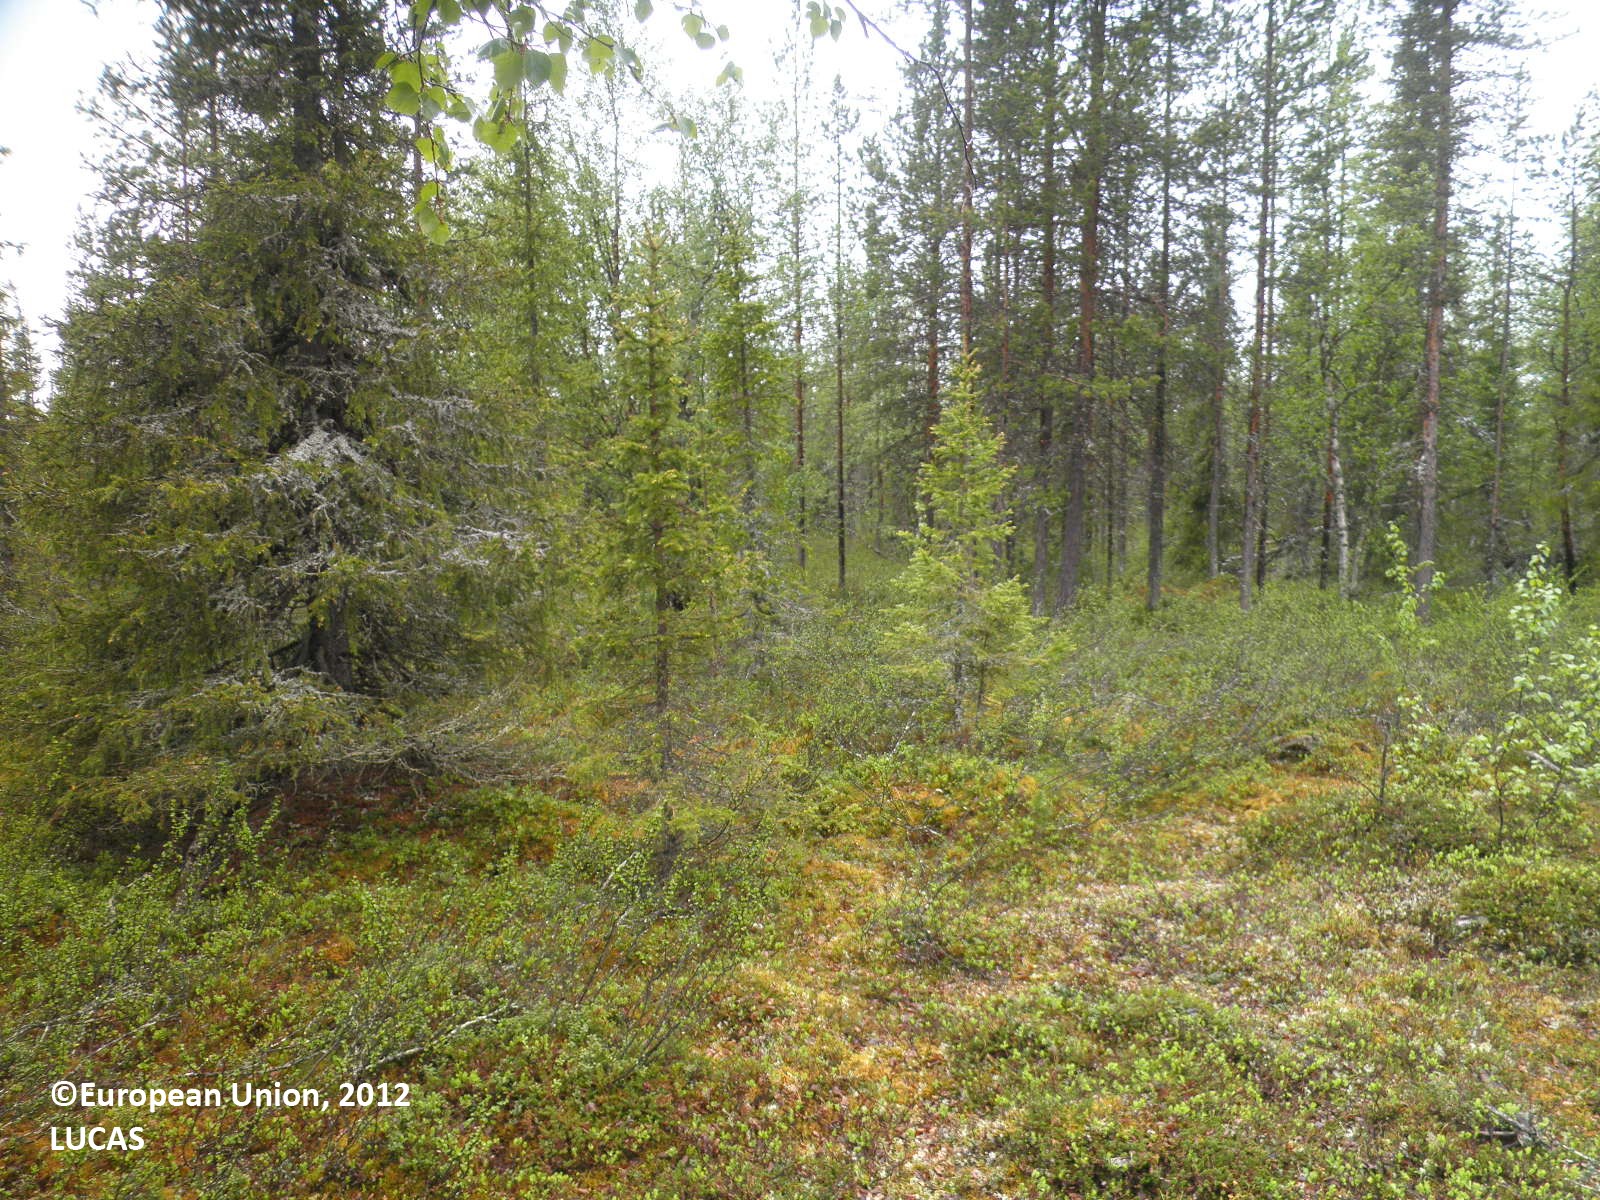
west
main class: Woodland
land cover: Pine dominated coniferous woodland
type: boreal forest
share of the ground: 50 - 75 %
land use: Forestry
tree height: > 5 m
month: June
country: FI
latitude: 67.9839
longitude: 25.5077
